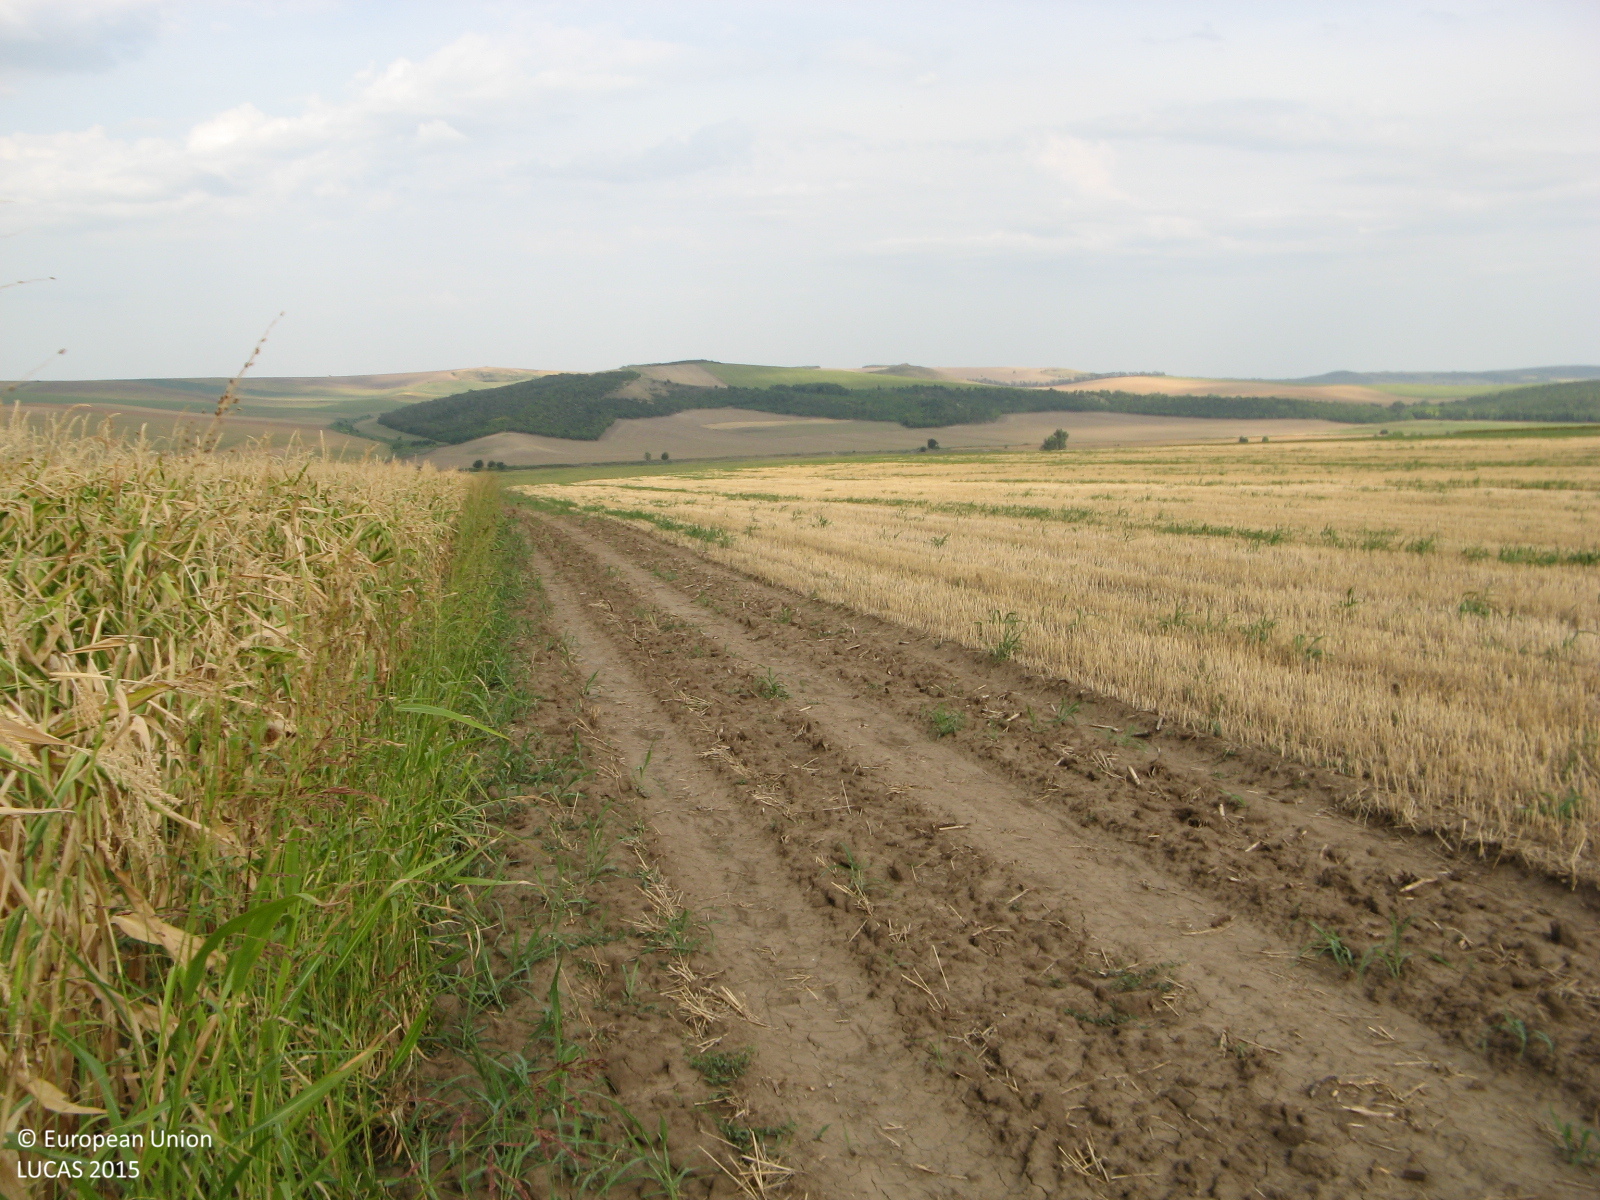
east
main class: Cropland
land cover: Maize
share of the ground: > 75 %
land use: Agriculture (excluding fallow land and kitchen gardens)
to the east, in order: Maize
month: August
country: BG
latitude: 43.4907
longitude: 25.2487
